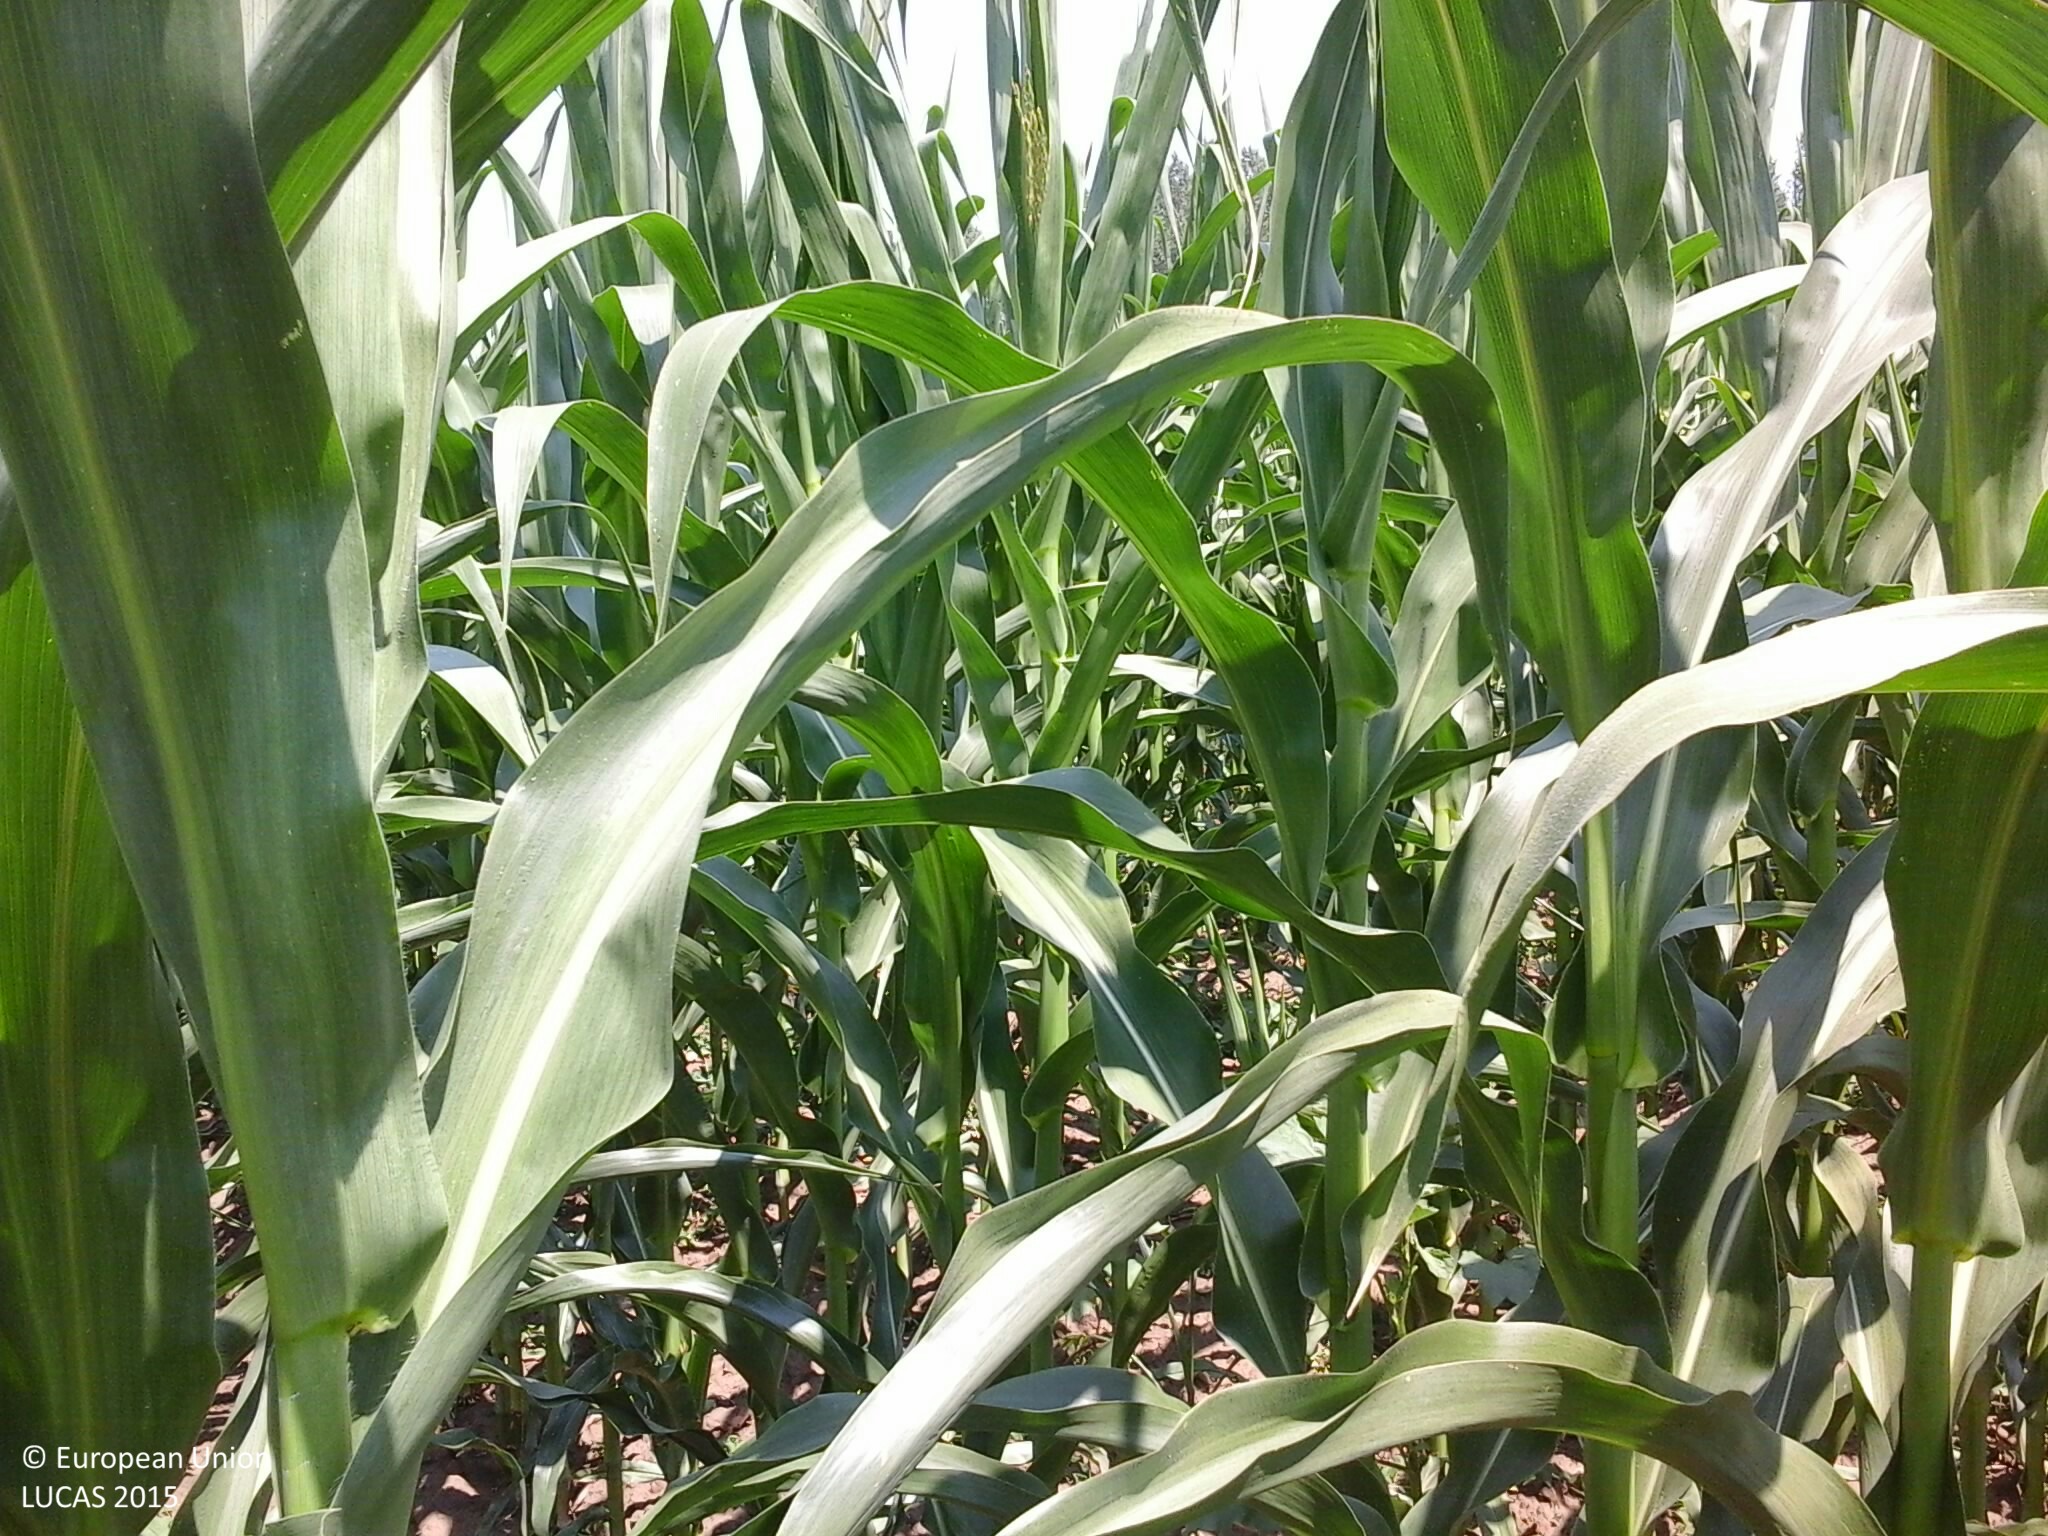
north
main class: Cropland
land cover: Maize
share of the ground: > 75 %
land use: Agriculture (excluding fallow land and kitchen gardens)
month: July
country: HU
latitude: 47.7929
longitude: 22.0800
